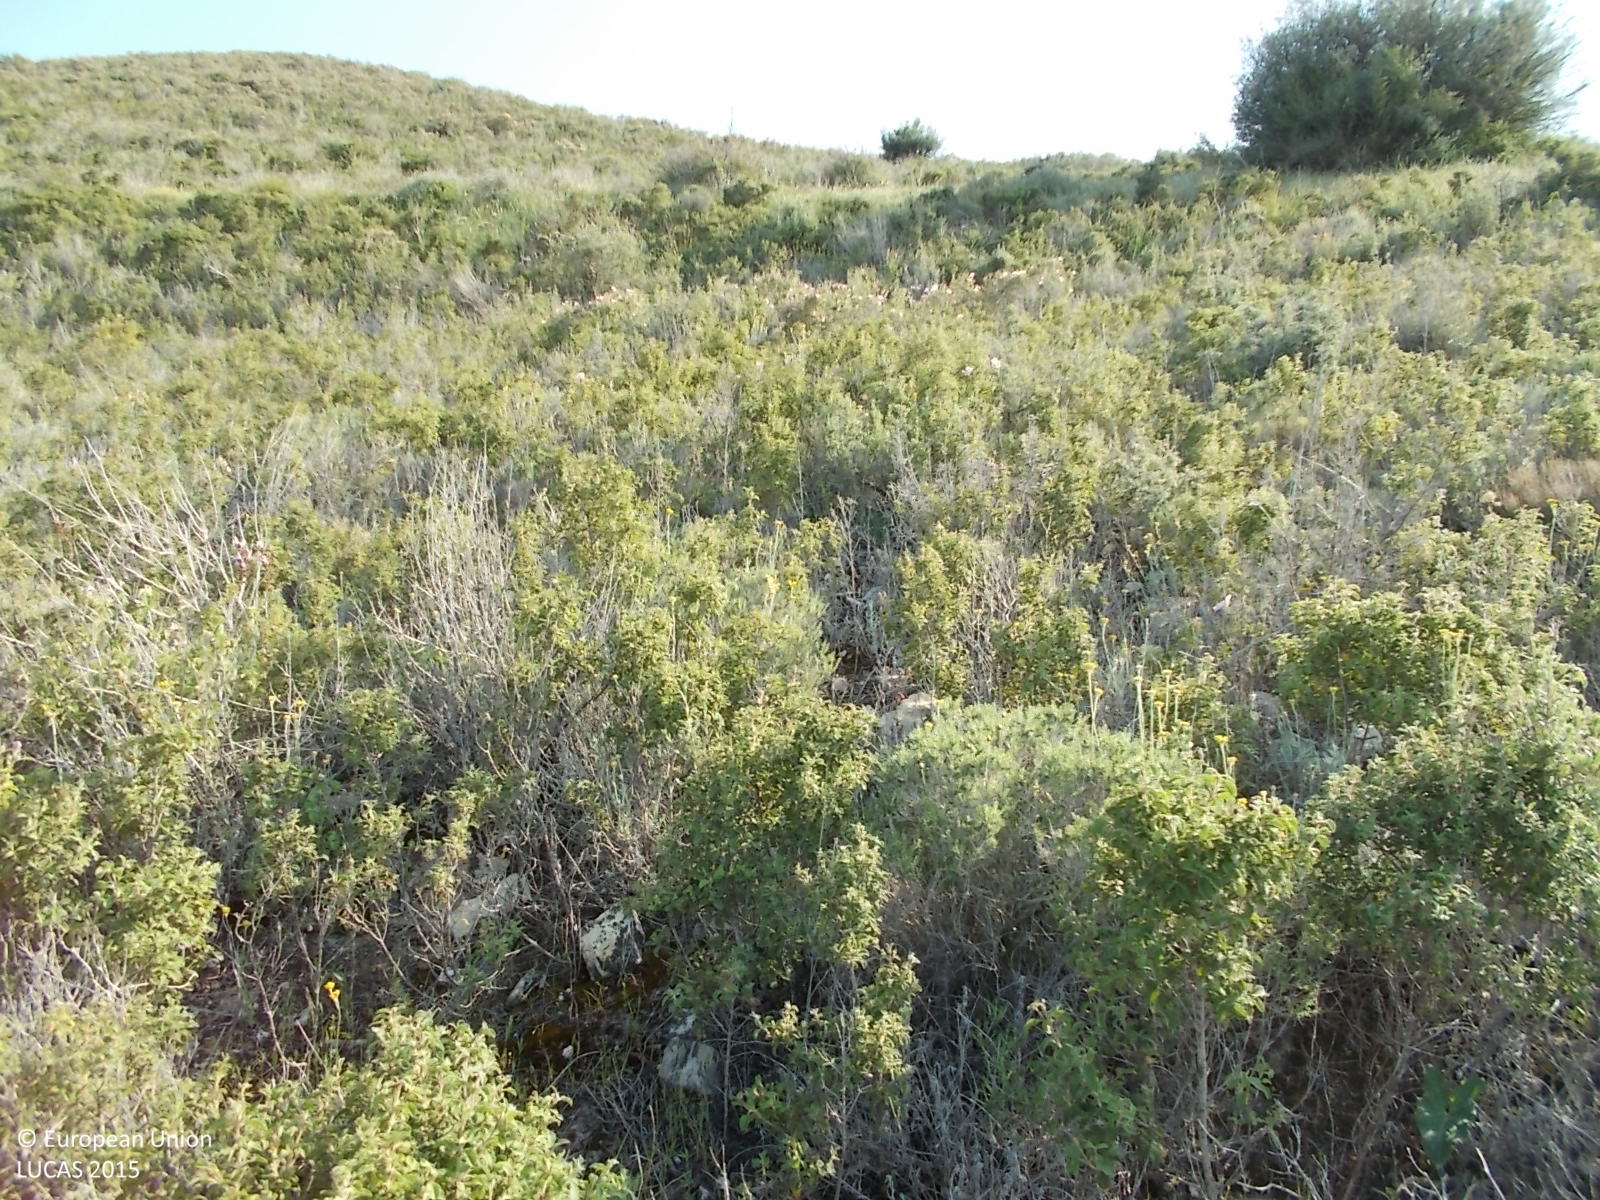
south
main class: Shrubland
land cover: Shrubland without tree cover
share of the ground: > 75 %
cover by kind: shrubs 100 %
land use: Semi-natural and natural areas not in use
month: April
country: CY
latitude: 34.9335
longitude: 33.4769
